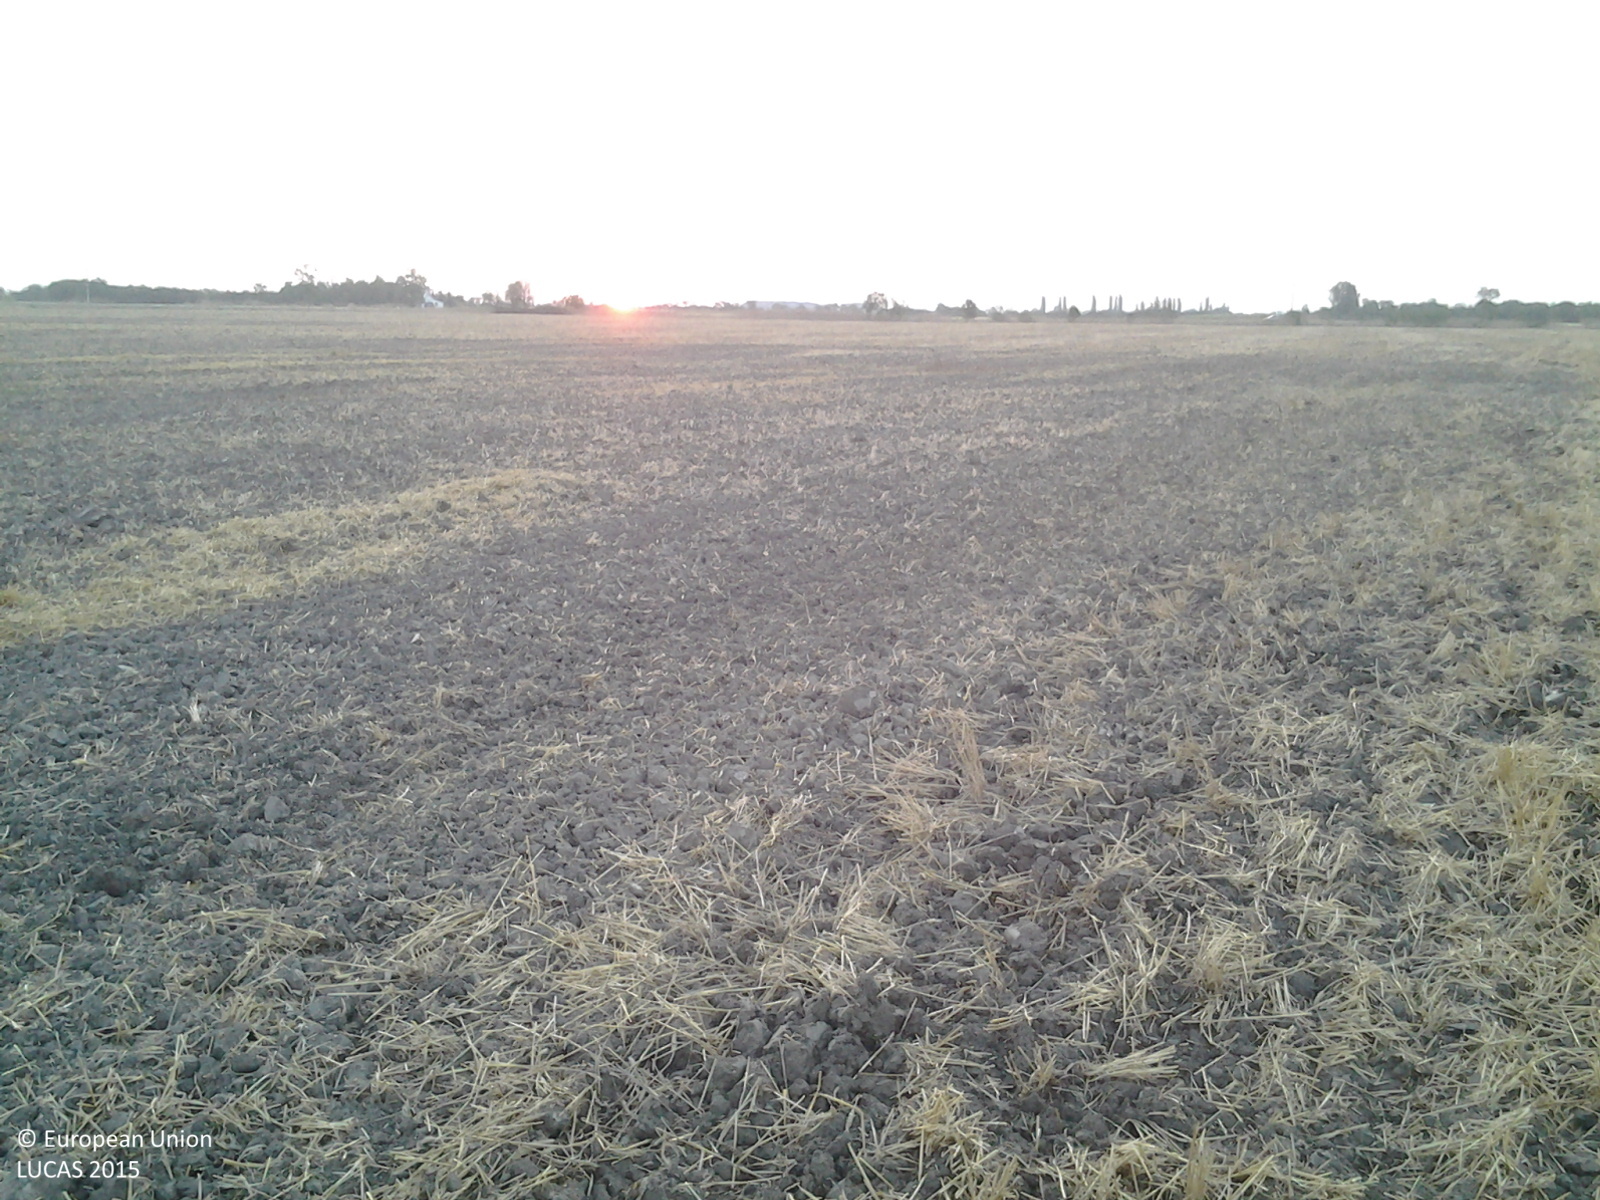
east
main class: Cropland
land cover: Common wheat
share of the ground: > 75 %
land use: Agriculture (excluding fallow land and kitchen gardens)
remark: Harvested field
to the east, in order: Common wheat
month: July
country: HU
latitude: 47.0617
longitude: 20.9222
